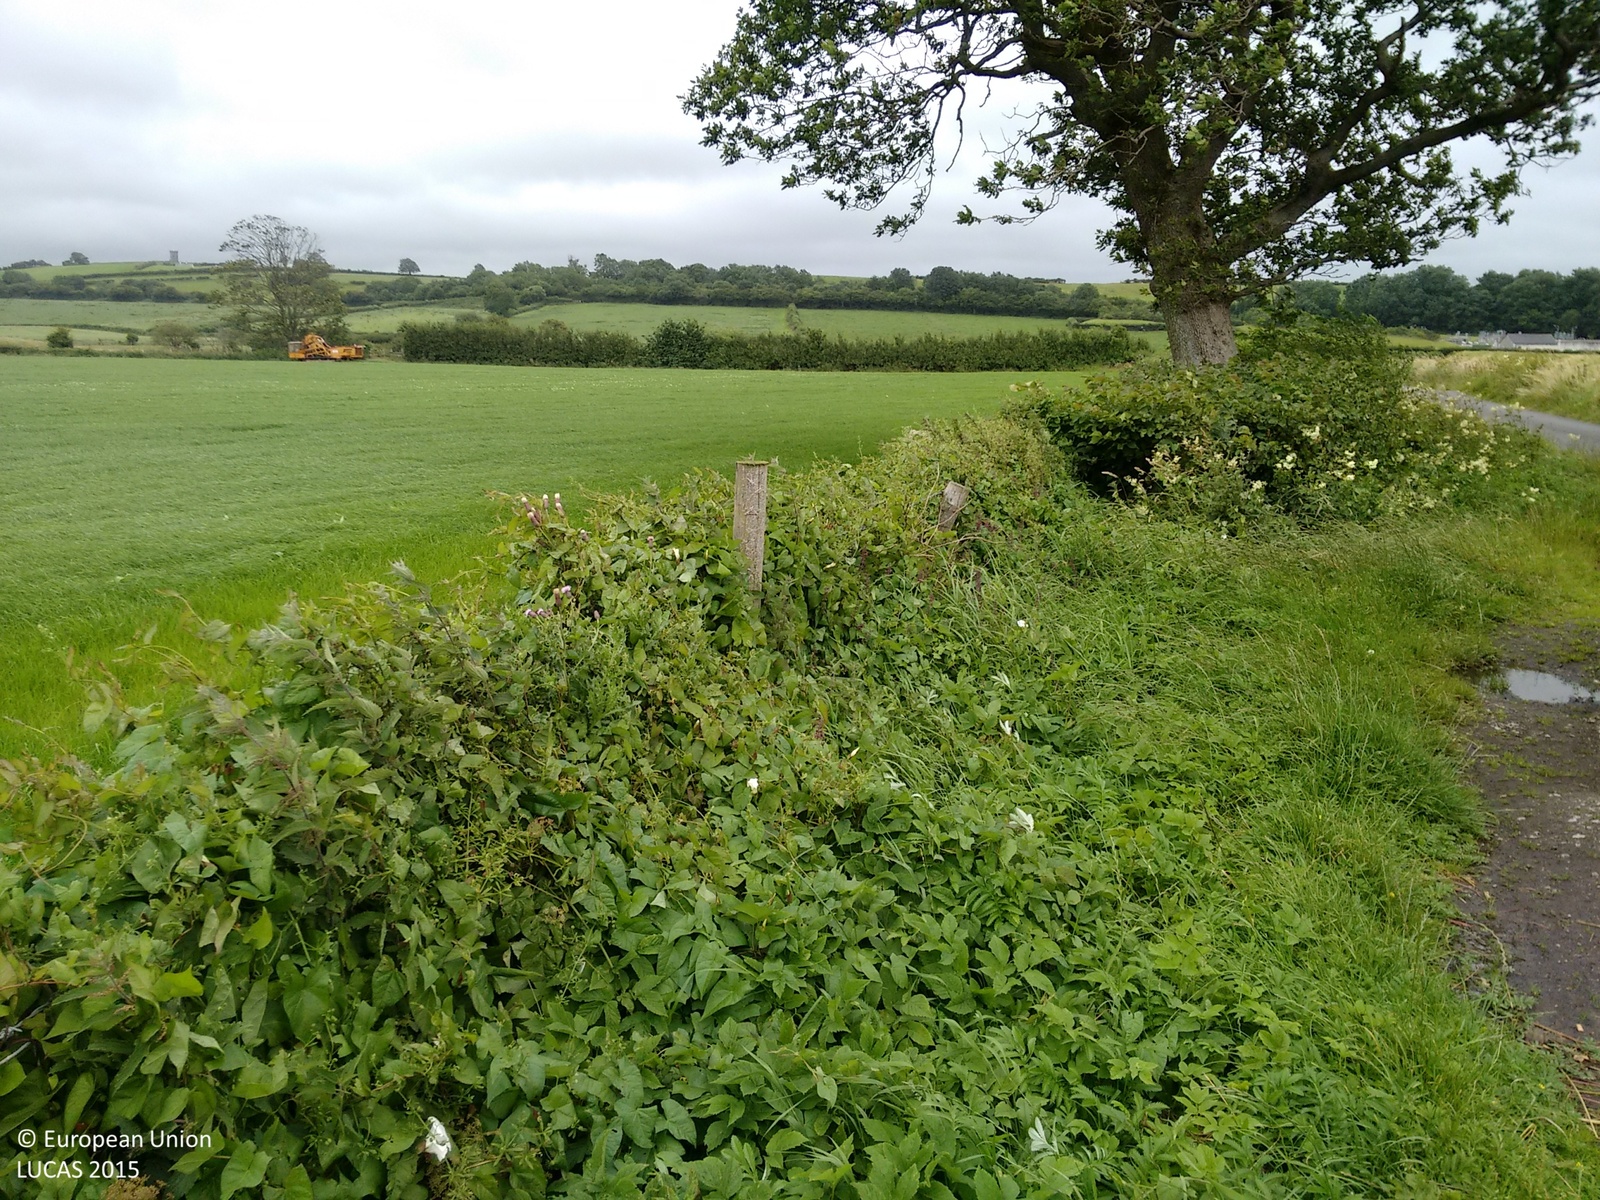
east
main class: Grassland
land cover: Grassland without tree/shrub cover
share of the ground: > 75 %
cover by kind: herbaceous plants 100 %
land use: Agriculture (excluding fallow land and kitchen gardens)
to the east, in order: Grassland without tree/shrub cover; Fences; Managed hedges; Inland fresh running water; Managed hedges; Grassland without tree/shrub cover; Managed hedges; Grassland without tree/shrub cover
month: August
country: GB
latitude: 54.2325
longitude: -2.7872
